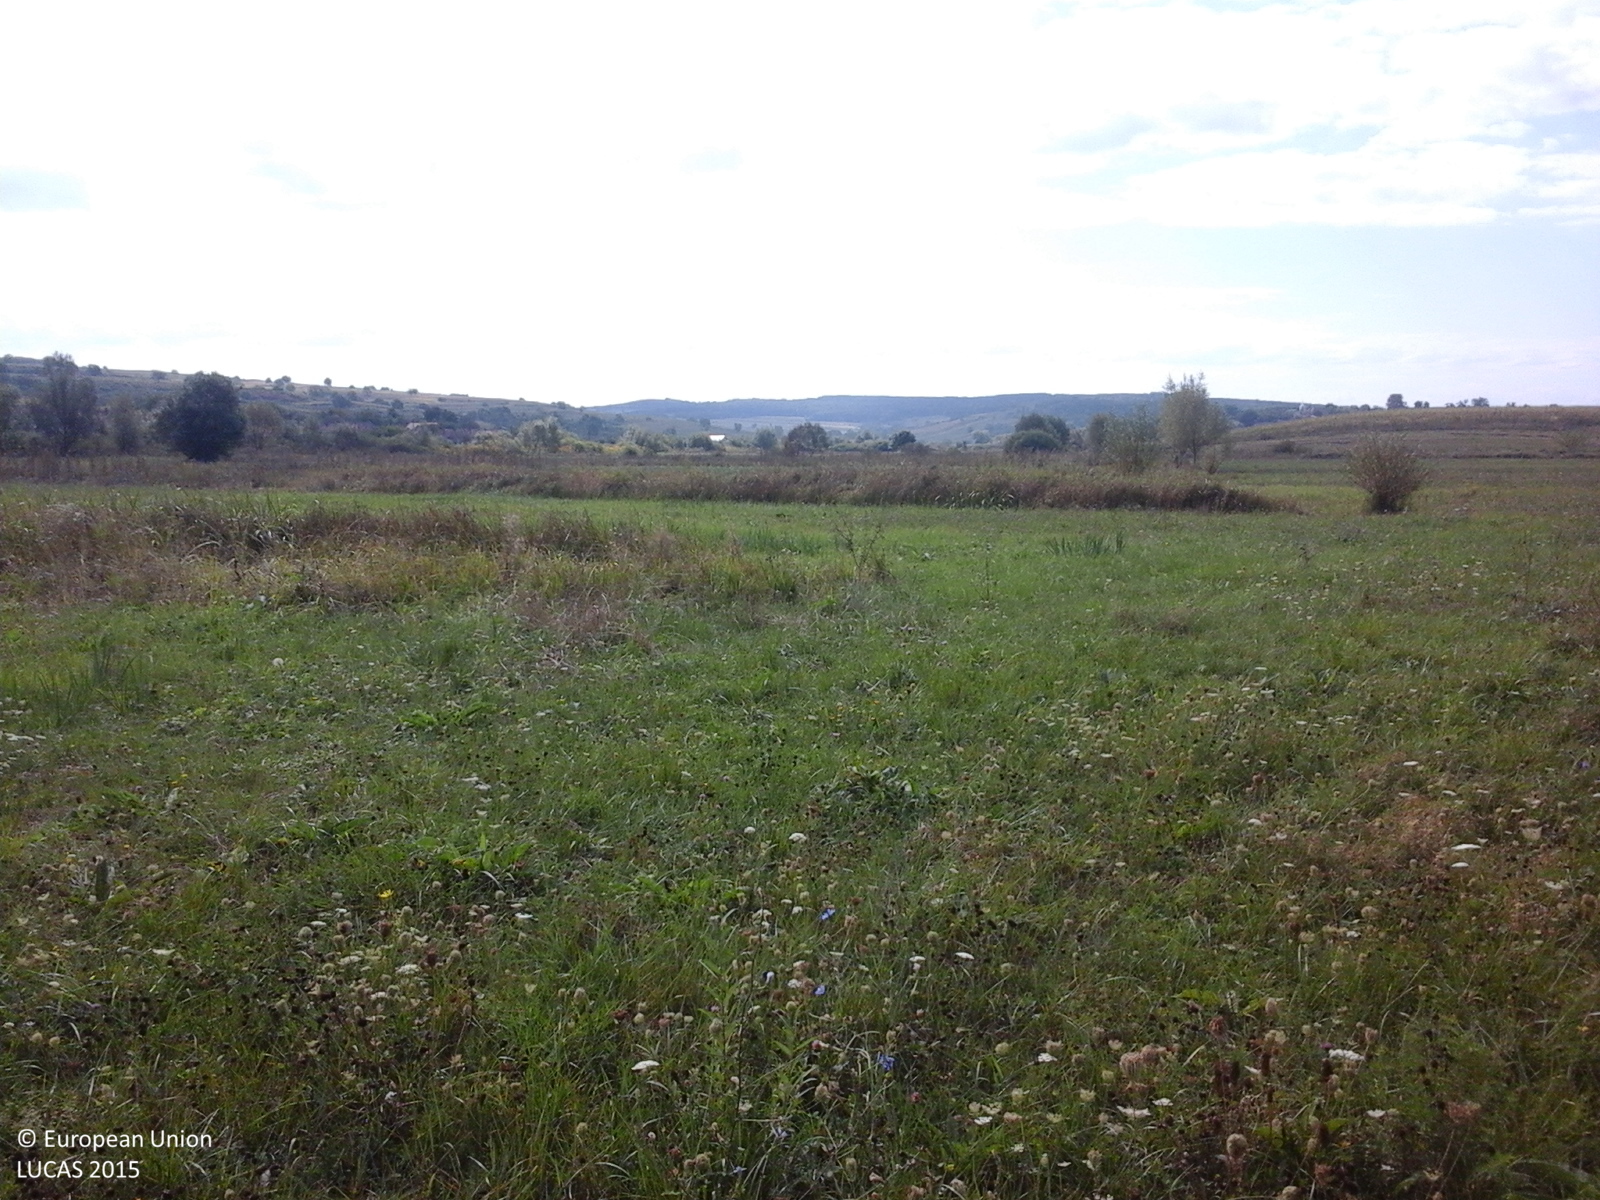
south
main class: Grassland
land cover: Grassland without tree/shrub cover
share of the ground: > 75 %
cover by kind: herbaceous plants 100 %
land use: Agriculture (excluding fallow land and kitchen gardens)
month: September
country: RO
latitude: 47.3783
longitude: 23.1393
